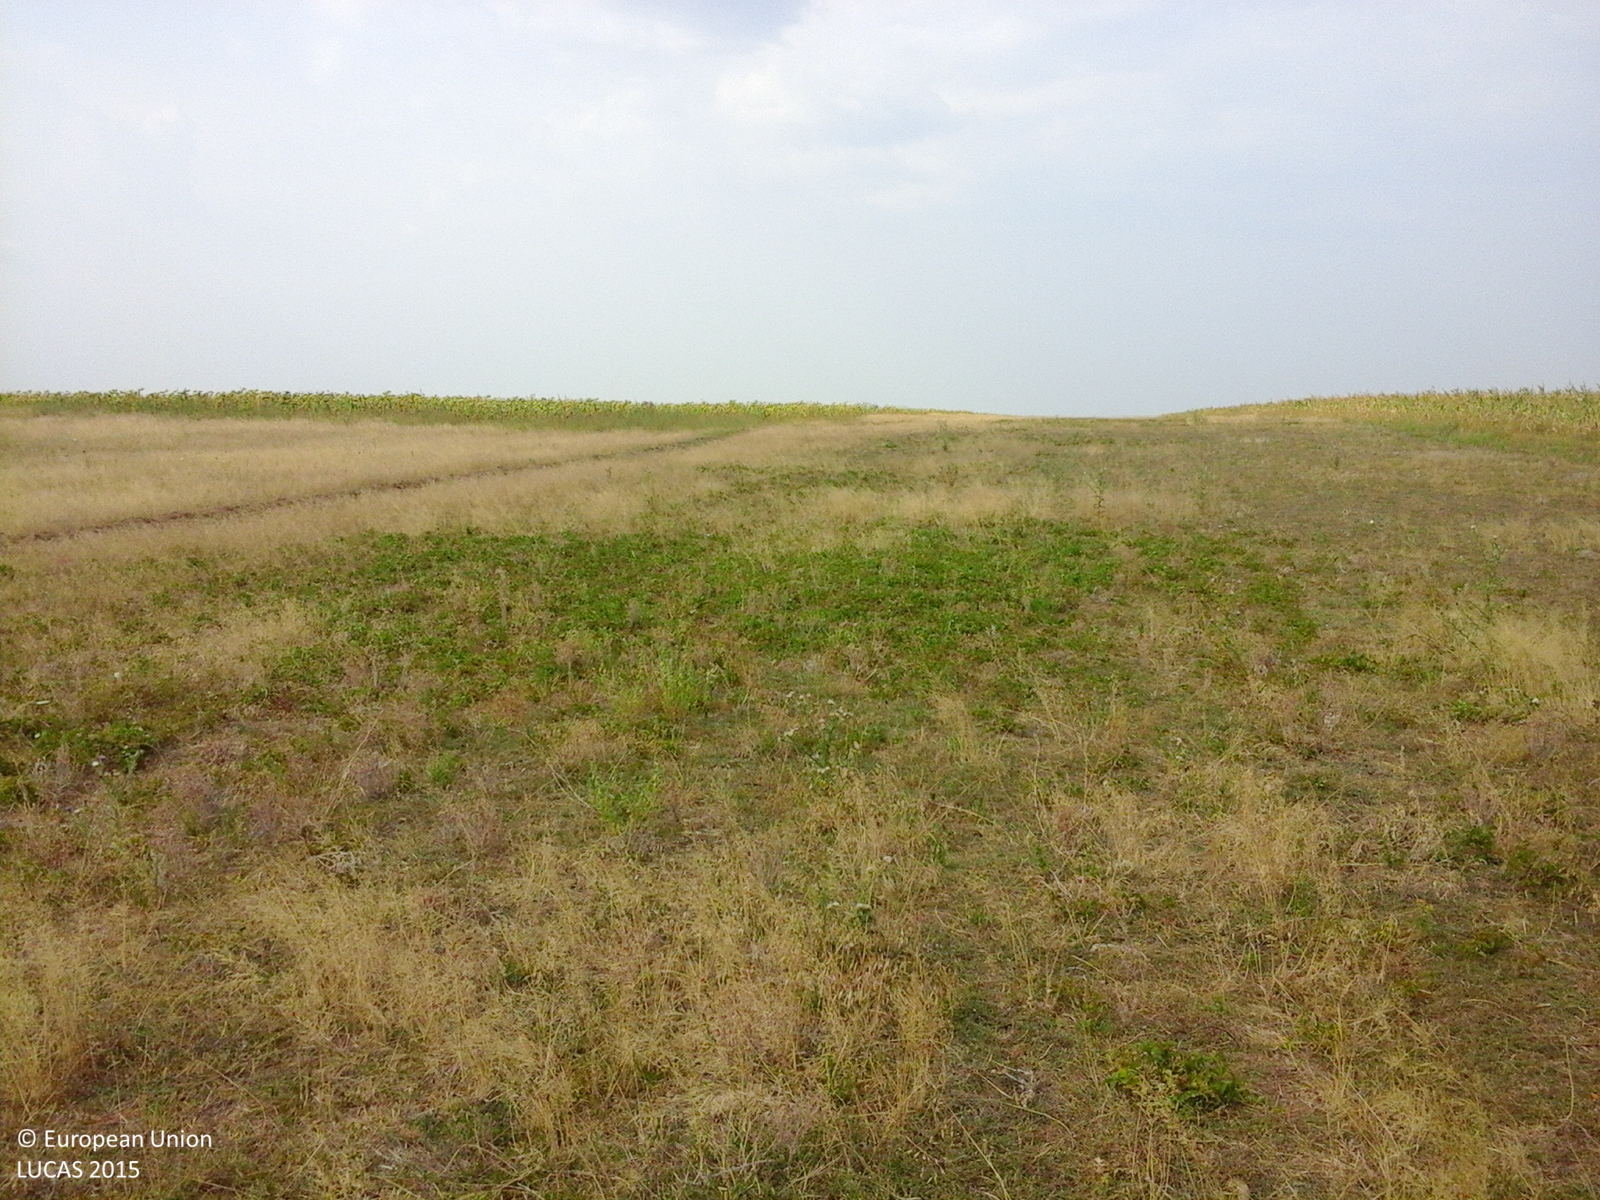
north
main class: Grassland
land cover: Grassland without tree/shrub cover
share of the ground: > 75 %
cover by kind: herbaceous plants 100 %
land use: Agriculture (excluding fallow land and kitchen gardens)
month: August
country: RO
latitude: 44.3131
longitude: 23.1474
